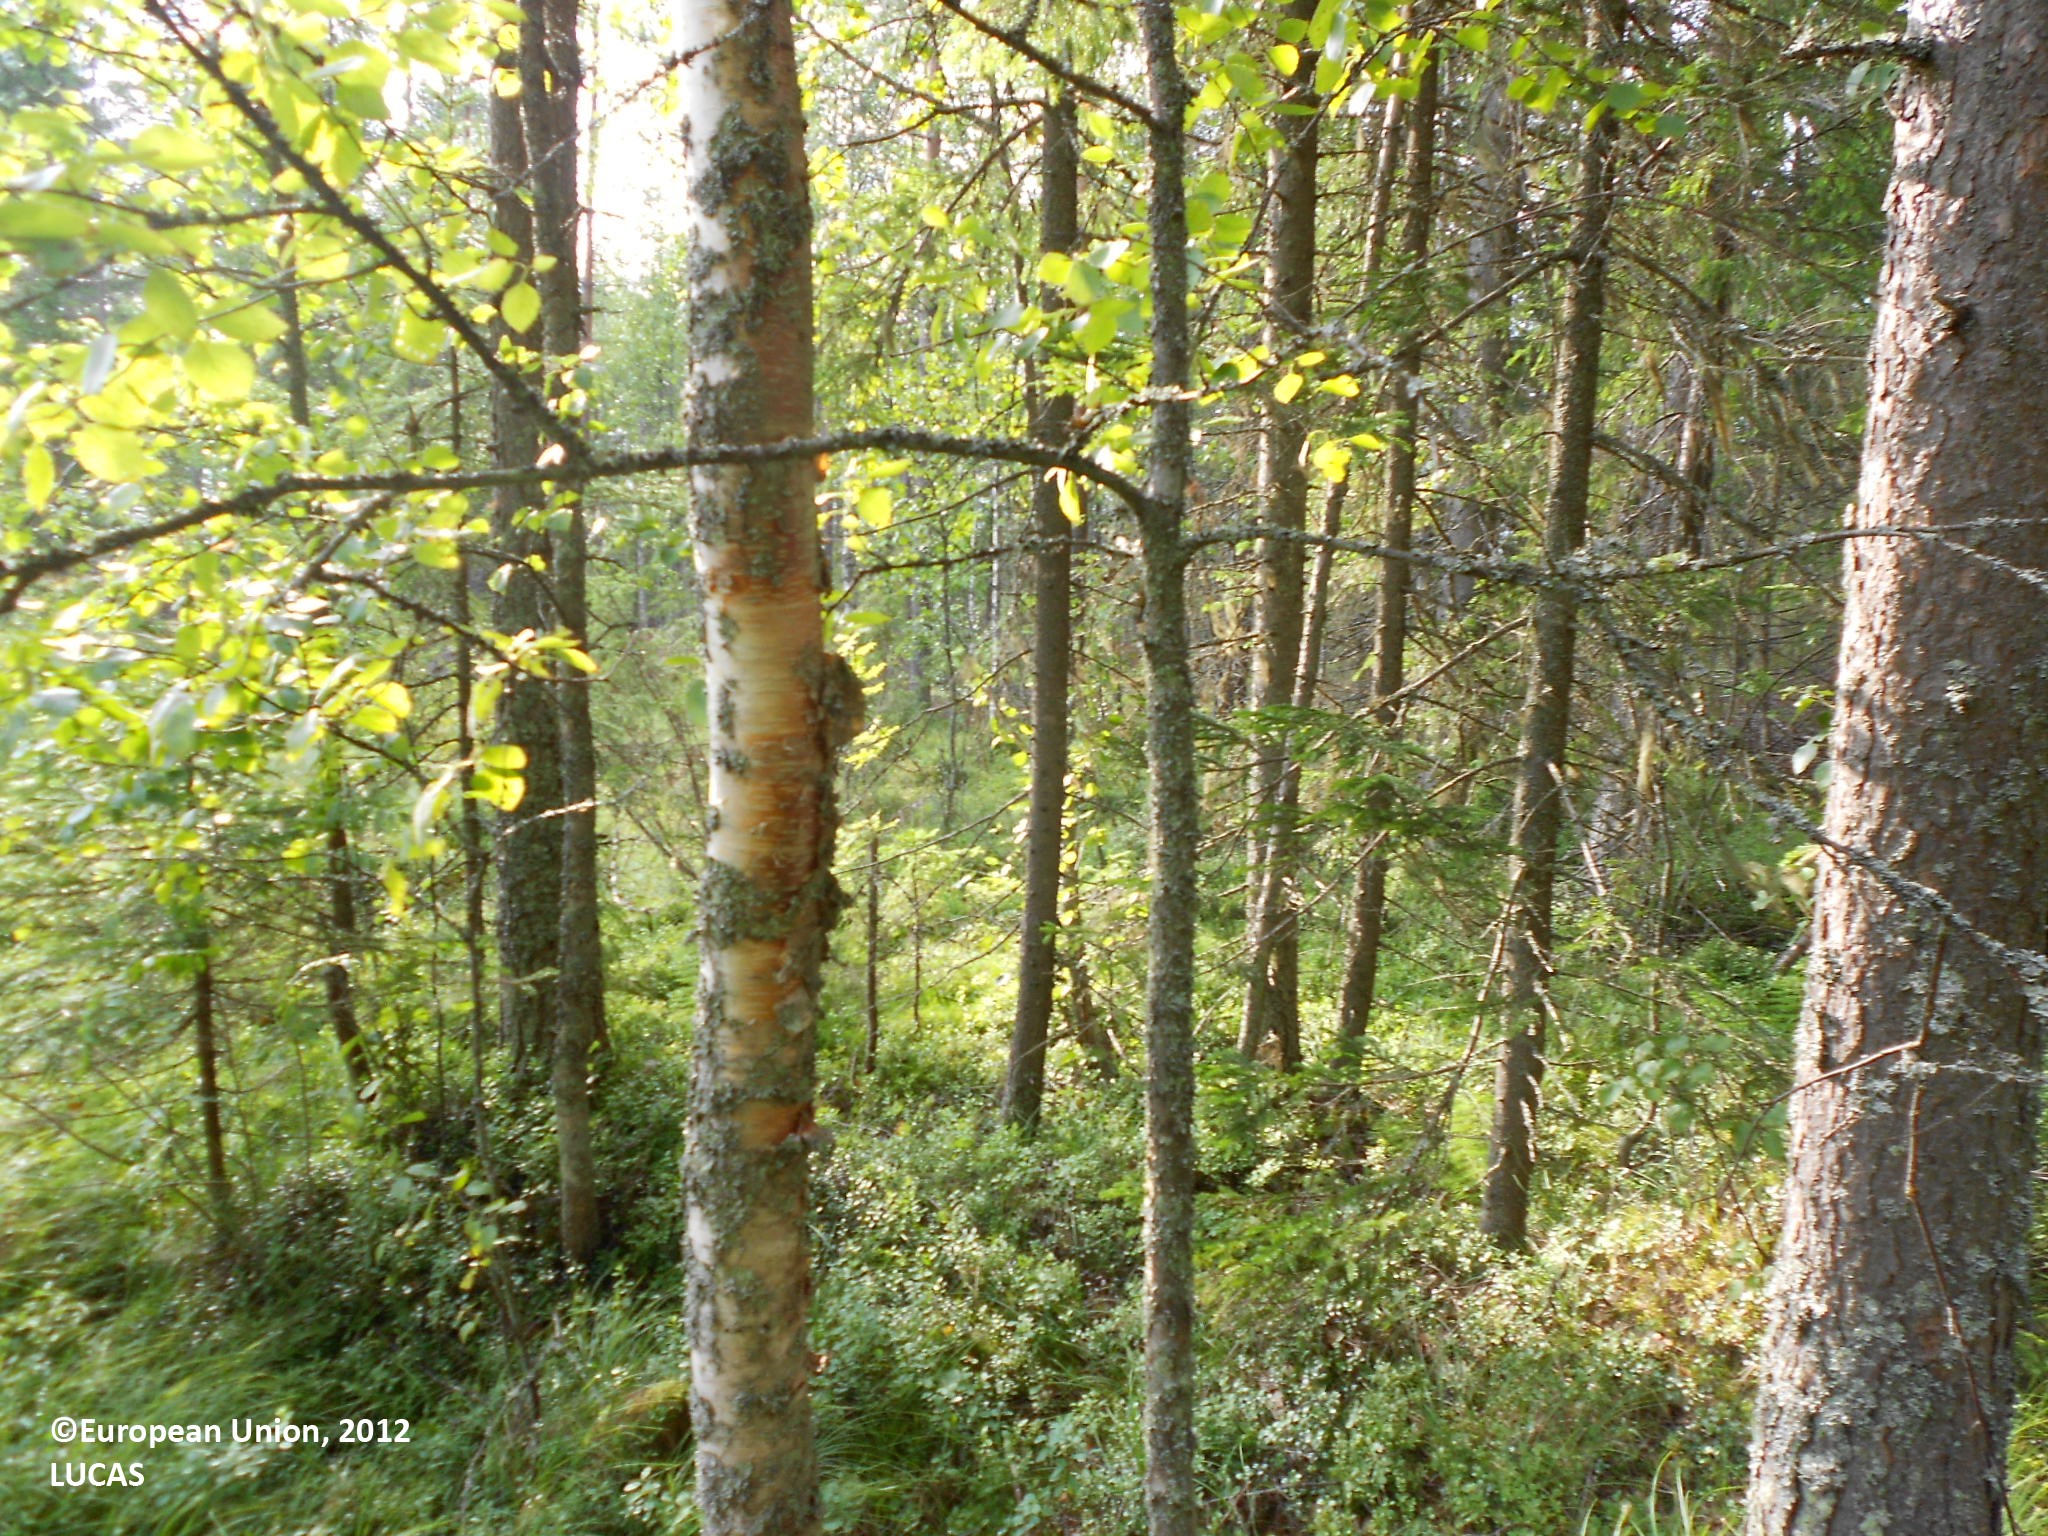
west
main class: Woodland
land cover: Spruce dominated coniferous woodland
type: boreal forest
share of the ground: > 75 %
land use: Forestry
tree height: > 5 m
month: August
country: FI
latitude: 63.4580
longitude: 28.8363
